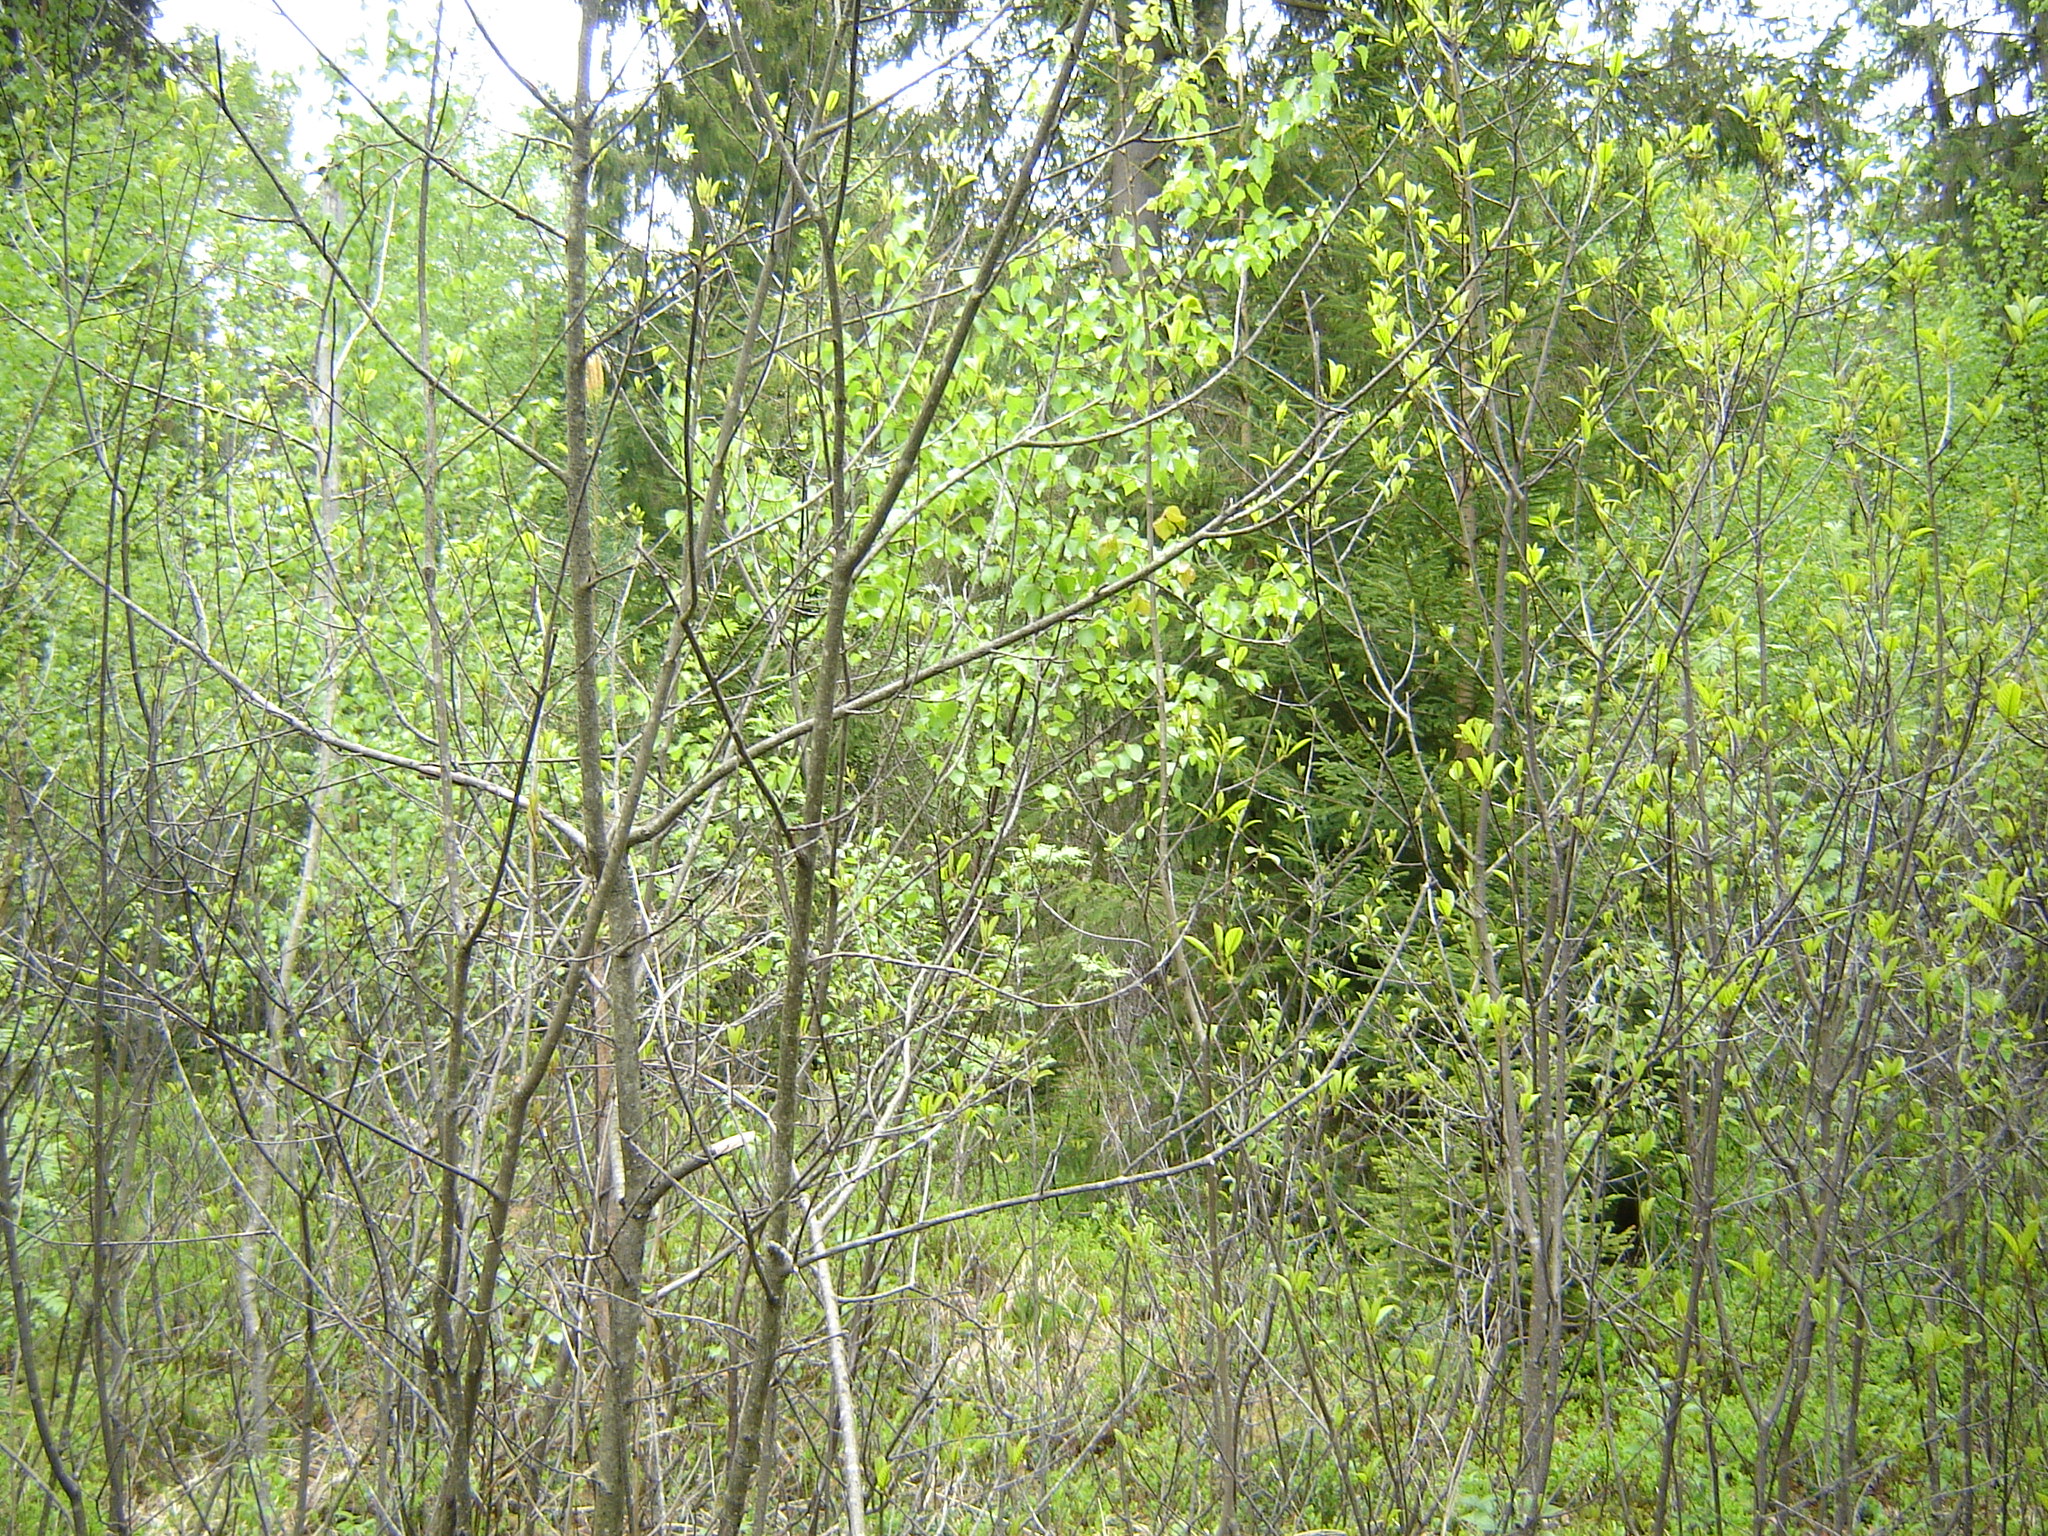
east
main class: Woodland
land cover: Other mixed woodland
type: hemiboreal forest and nemoral coniferous forest and mixed broadleaved-coniferous forest
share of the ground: > 75 %
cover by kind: coniferous forest trees 50 %, broadleaved forest trees 50 %
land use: Forestry
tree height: > 5 m
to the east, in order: Other mixed woodland; Tracks; Pine dominated coniferous woodland; Broadleaved woodland; Pine dominated coniferous woodland
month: May
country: LT
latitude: 56.1221
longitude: 25.3181
